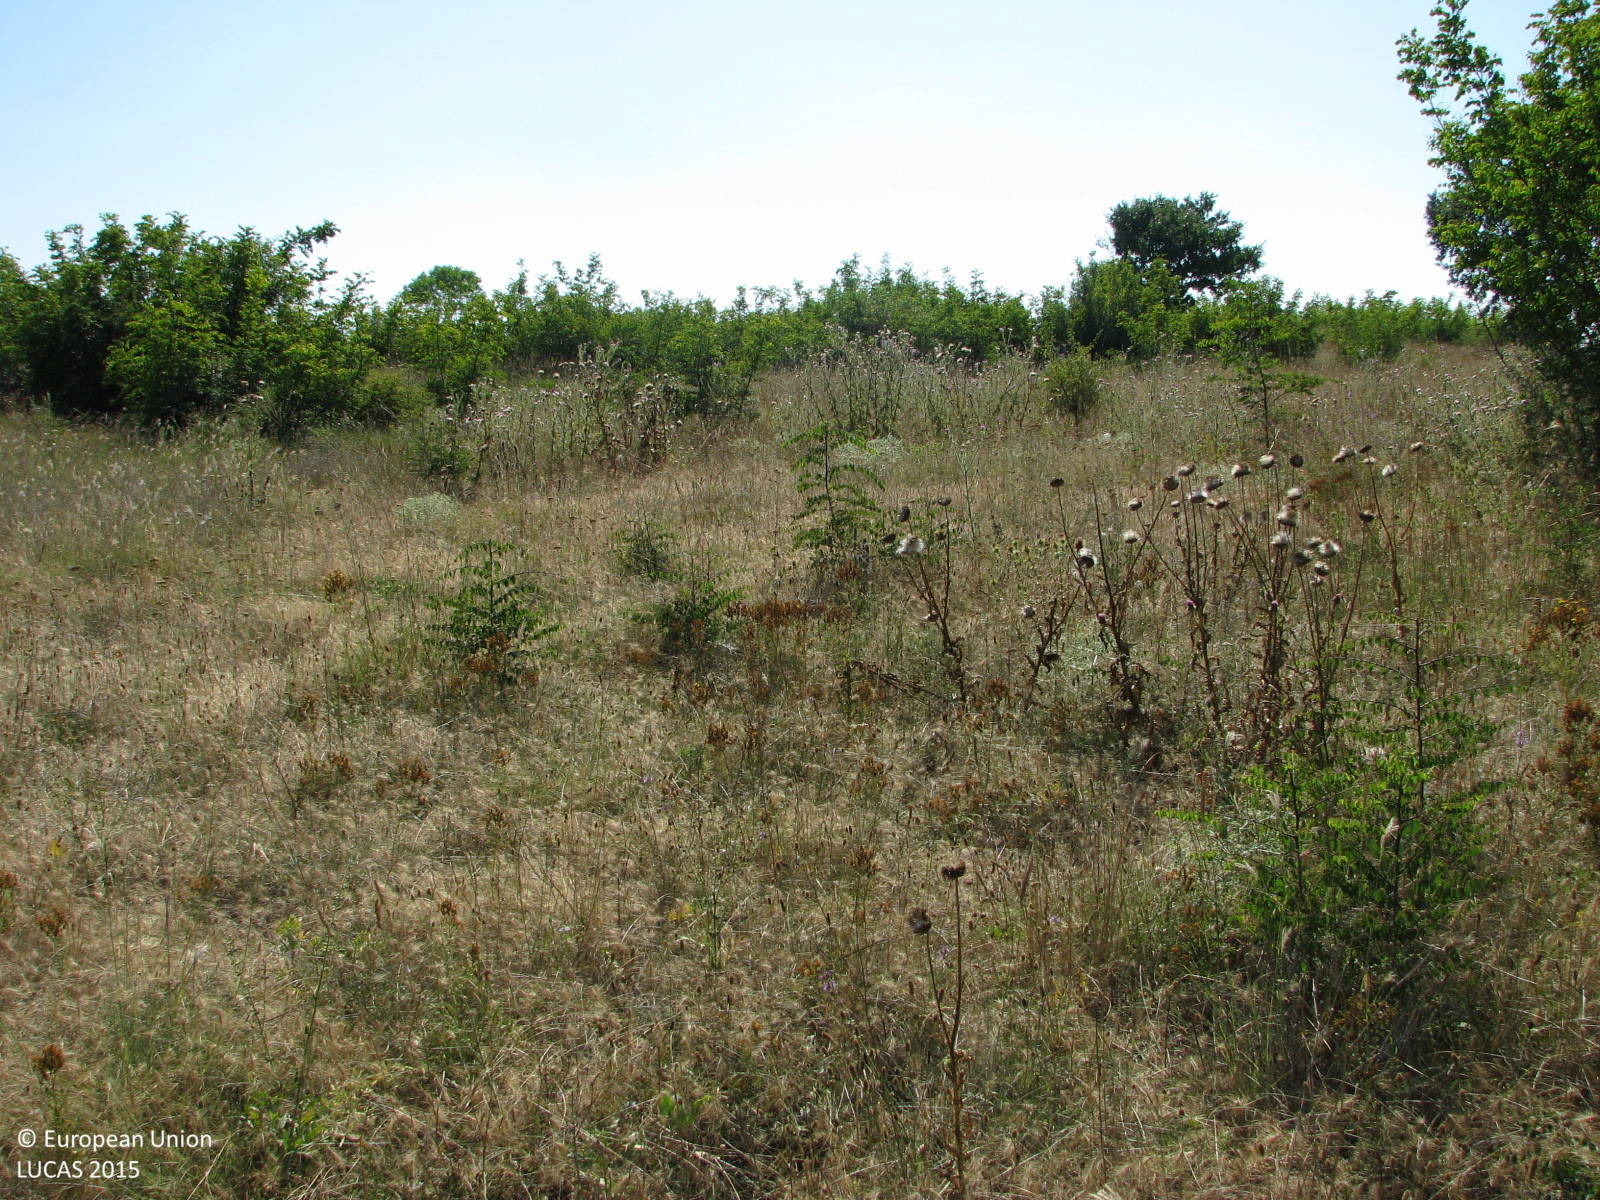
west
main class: Shrubland
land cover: Shrubland without tree cover
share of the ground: > 75 %
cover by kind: herbaceous plants 80 %, shrubs 20 %
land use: Semi-natural and natural areas not in use
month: July
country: BG
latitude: 42.2766
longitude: 26.8678
